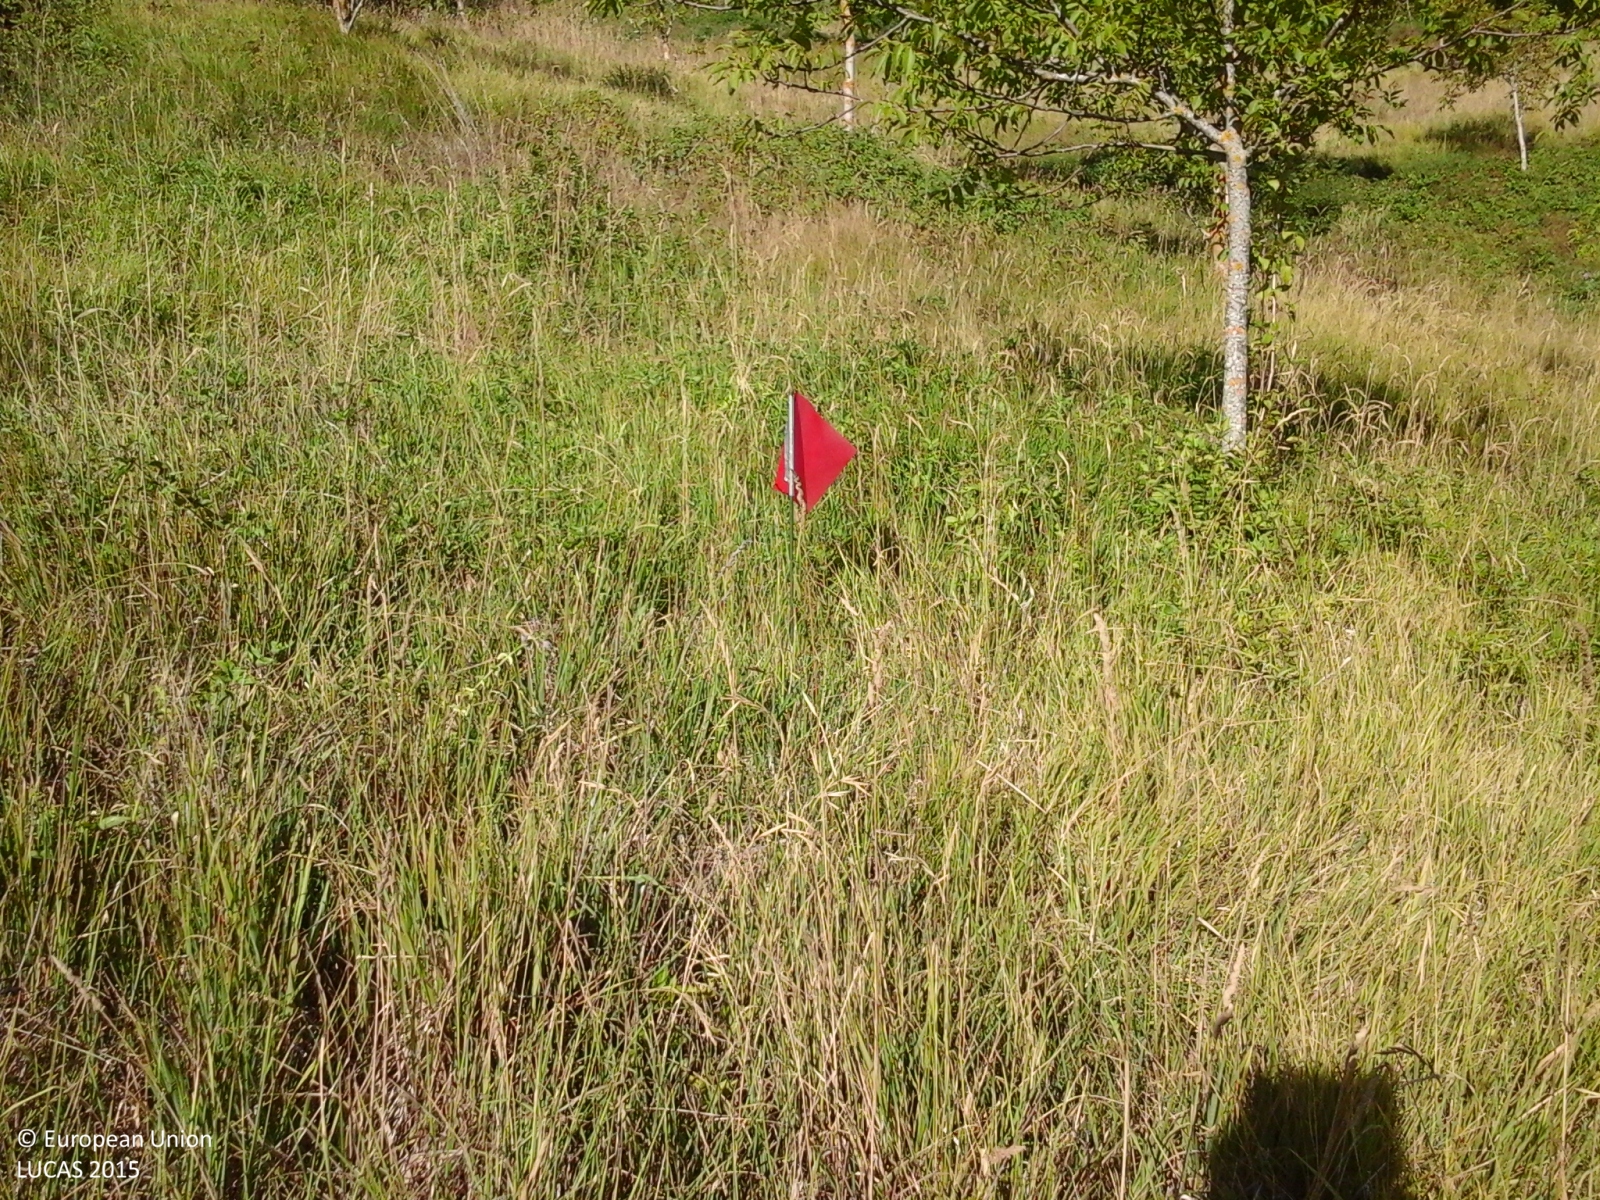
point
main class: Cropland
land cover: Nuts trees
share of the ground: 25 - 50 %
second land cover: Grassland without tree/shrub cover
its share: > 75 %
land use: Agriculture (excluding fallow land and kitchen gardens)
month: August
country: IT
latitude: 43.5279
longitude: 12.4312
